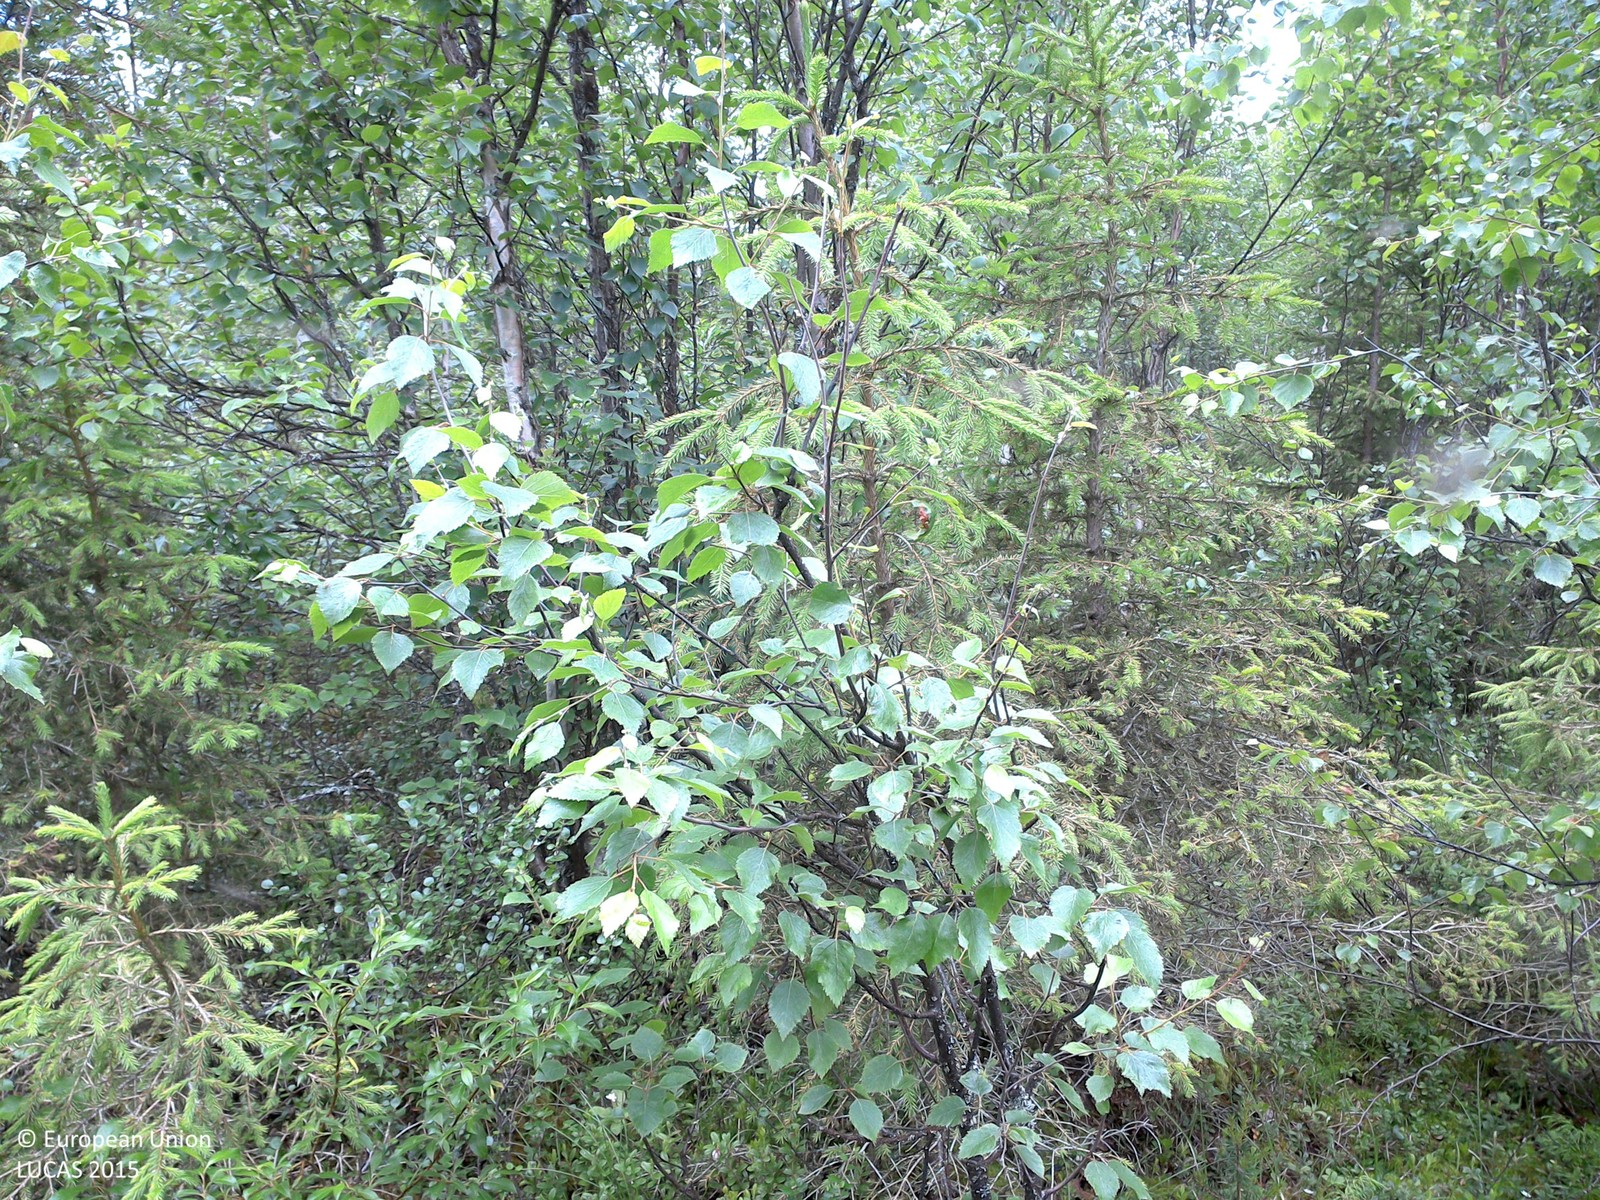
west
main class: Woodland
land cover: Other mixed woodland
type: boreal forest
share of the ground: 25 - 50 %
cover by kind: shrubs 65 %, broadleaved forest trees 20 %, coniferous forest trees 10 %, lichens and mosses 5 %
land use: Forestry
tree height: > 5 m
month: July
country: SE
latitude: 66.8234
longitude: 23.8972
